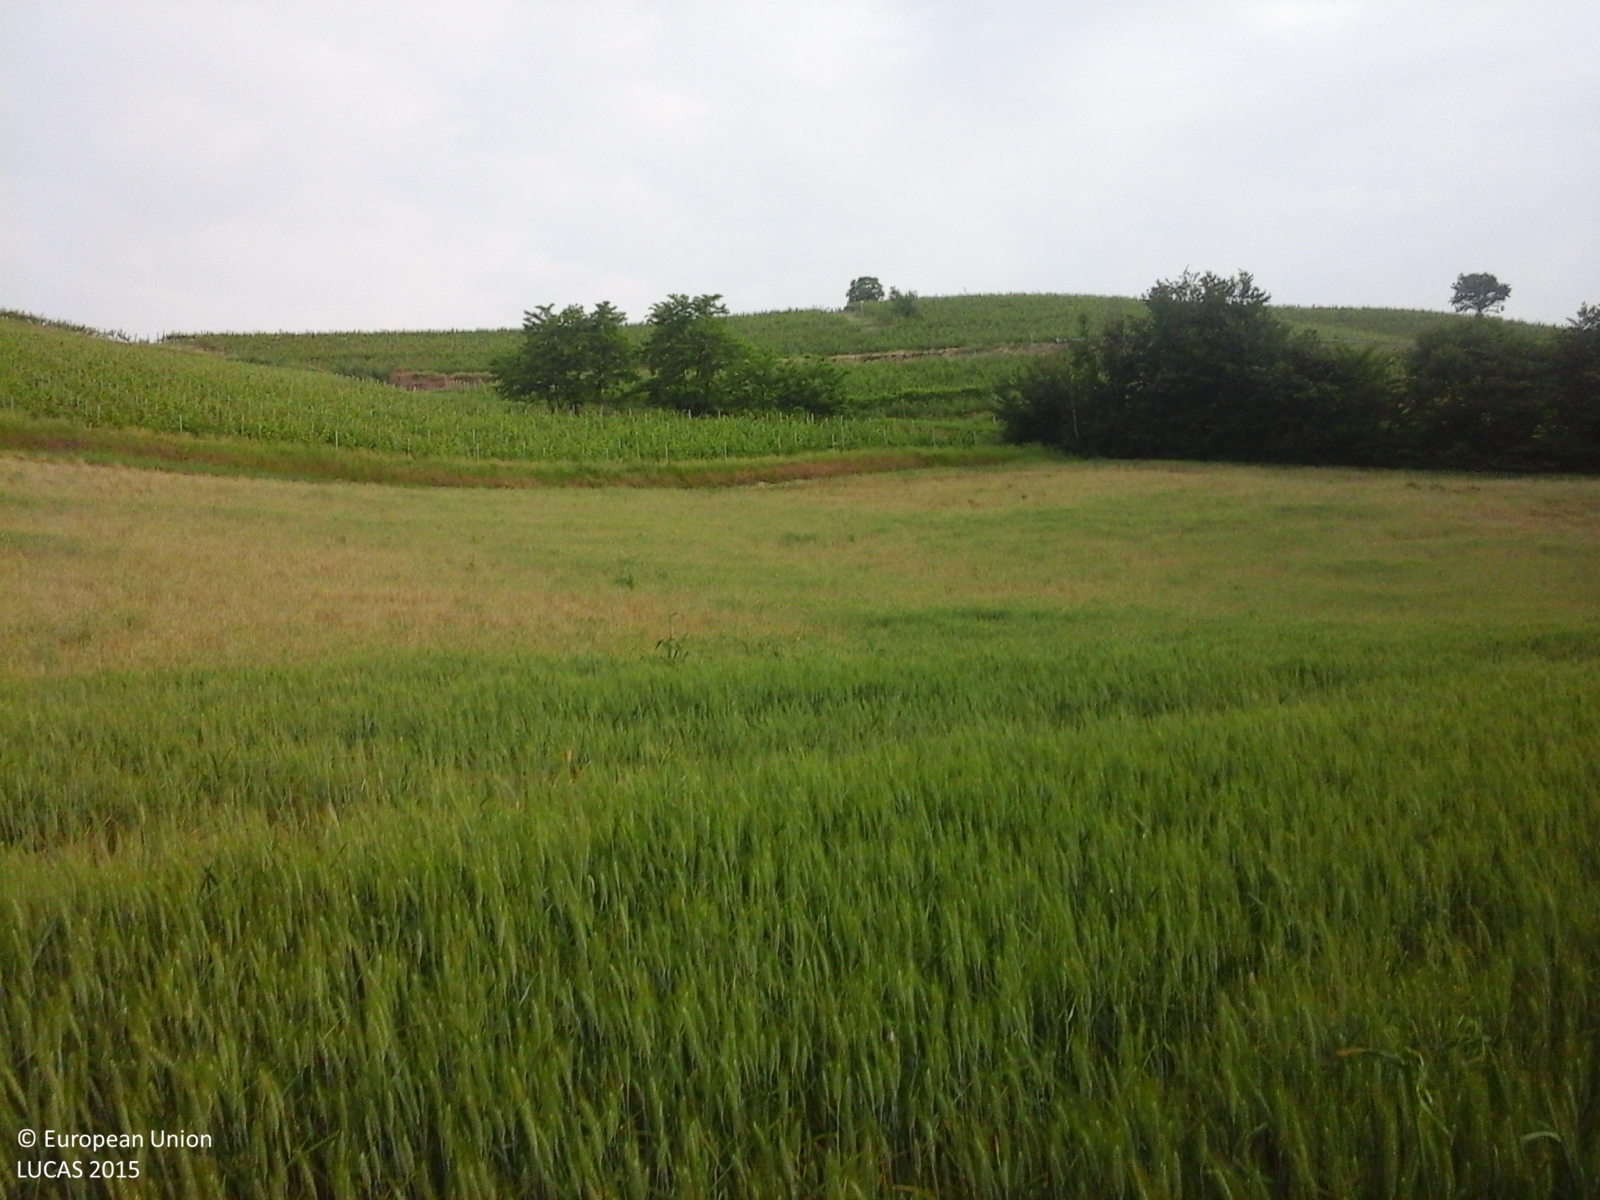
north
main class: Cropland
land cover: Common wheat
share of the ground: > 75 %
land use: Agriculture (excluding fallow land and kitchen gardens)
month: May
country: IT
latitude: 44.8205
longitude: 8.1193
